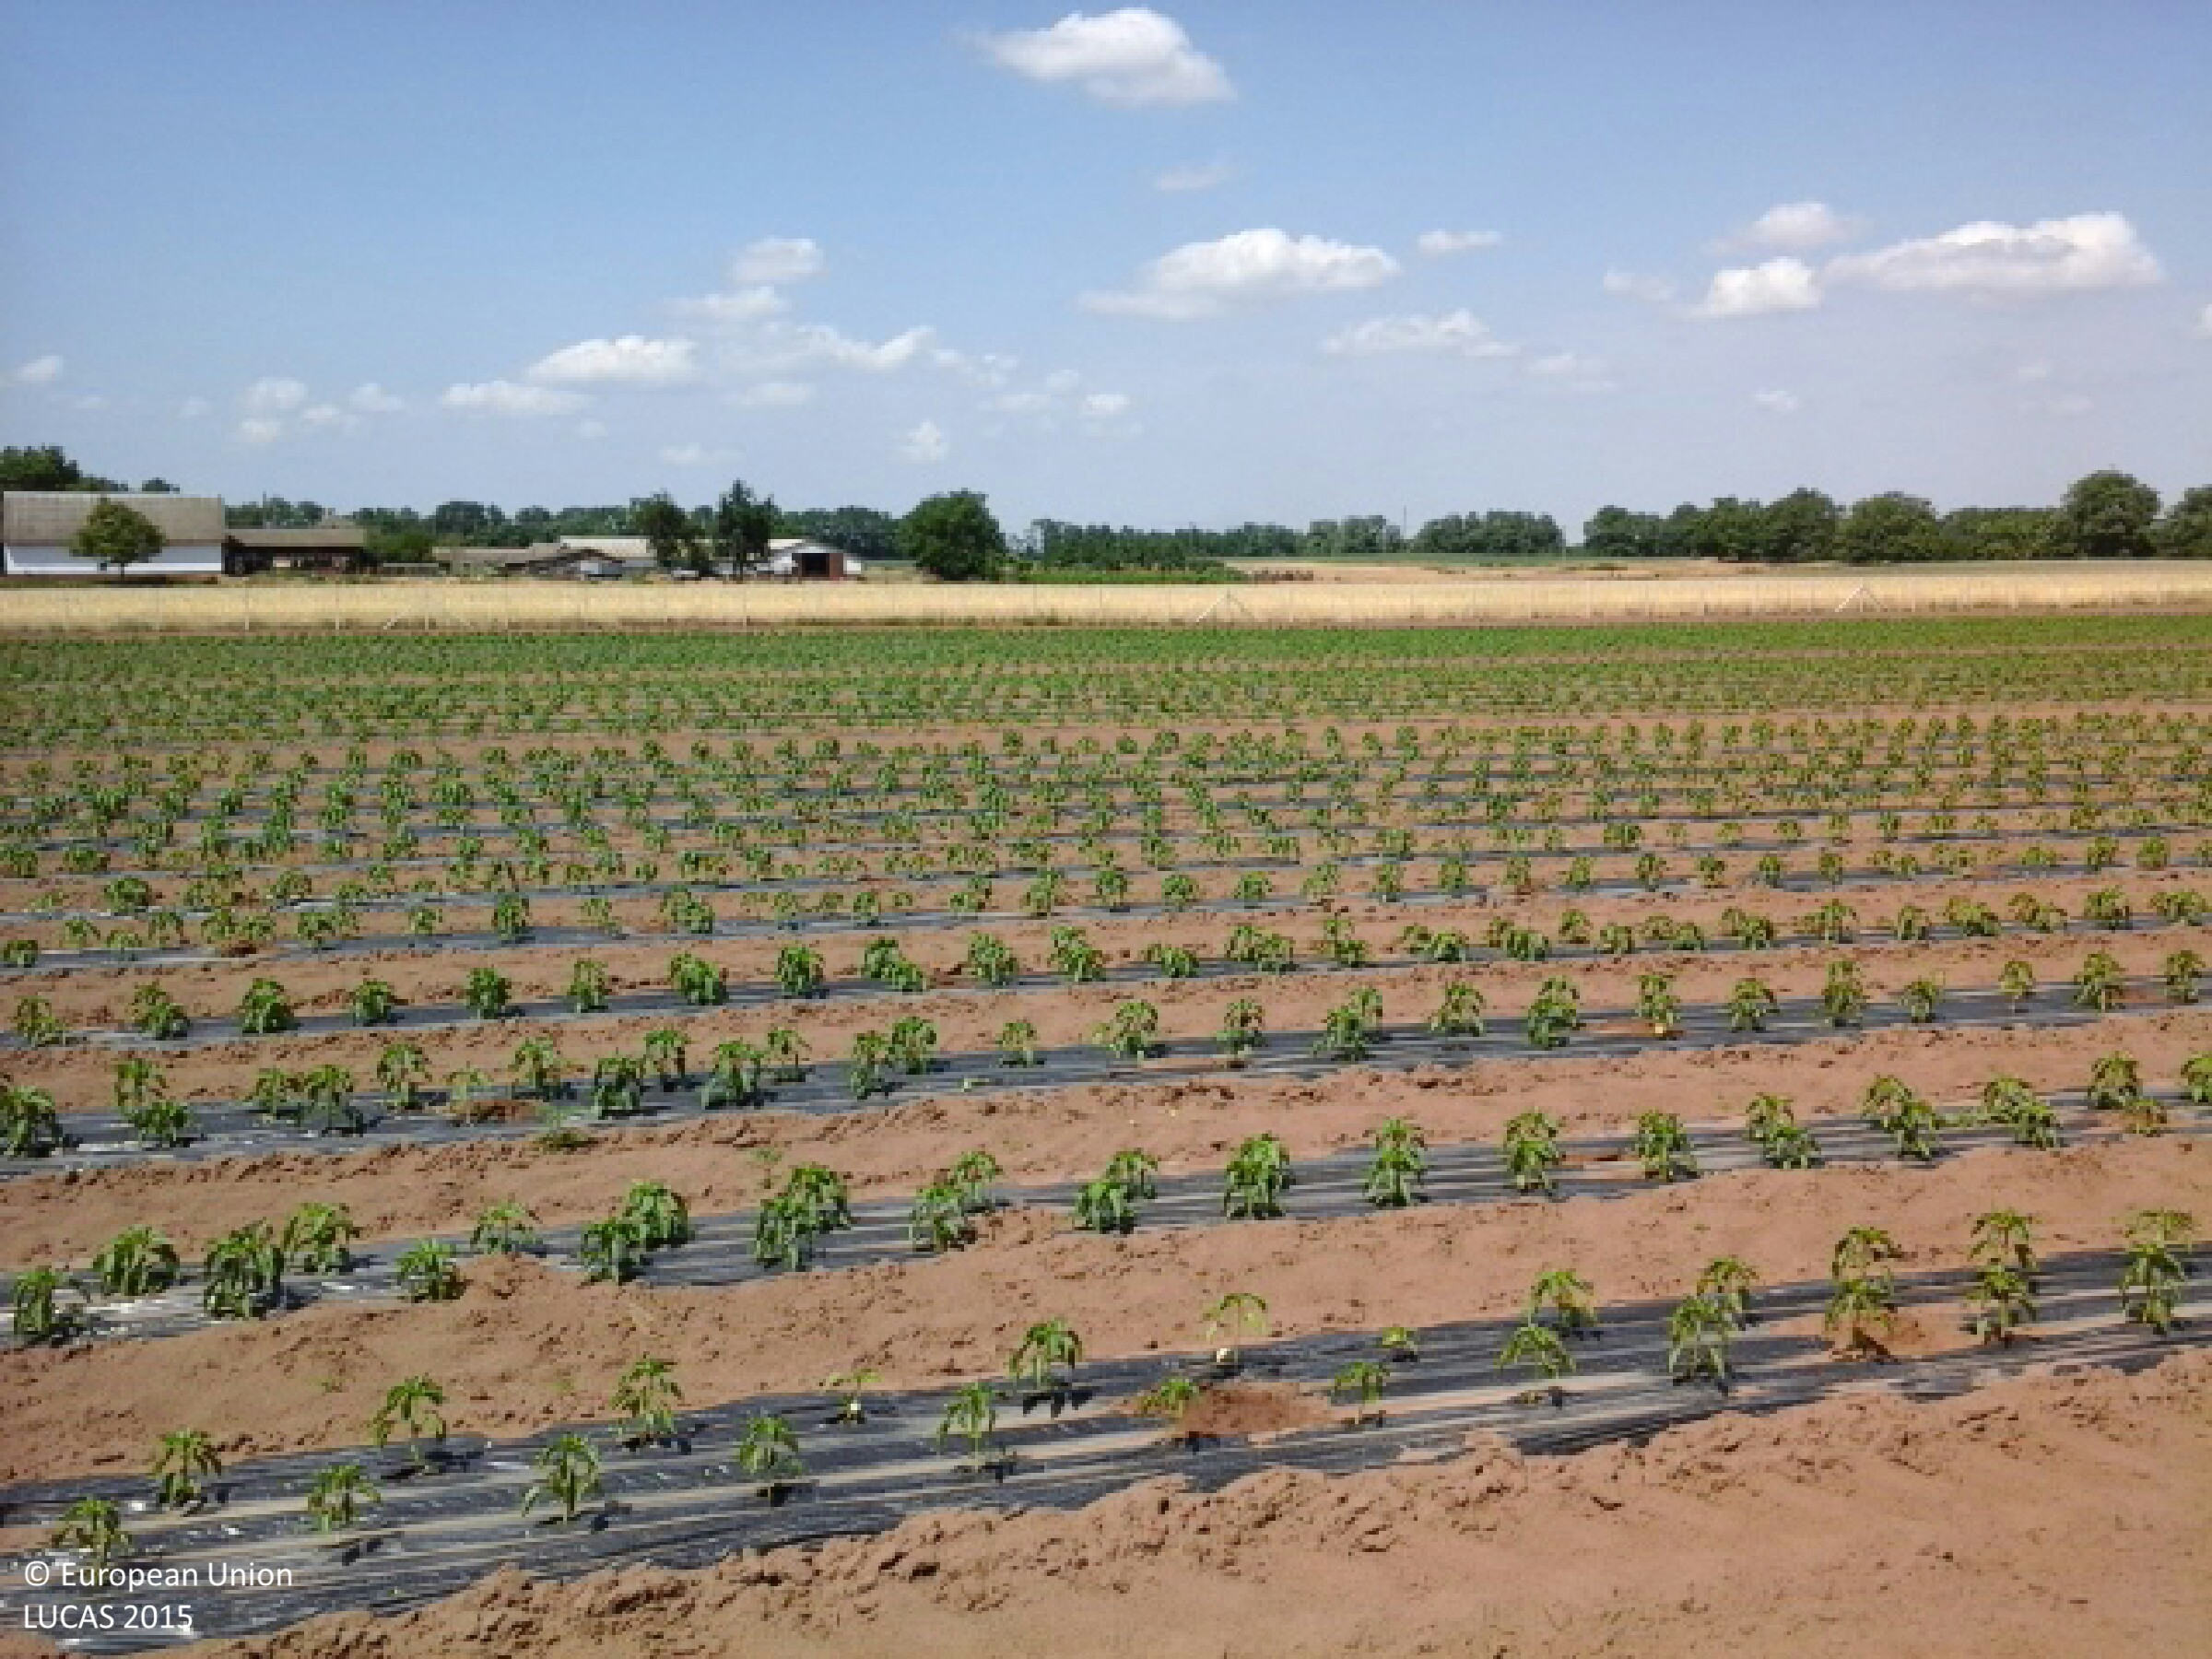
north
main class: Cropland
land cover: Other fresh vegetables
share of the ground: 10 - 25 %
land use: Agriculture (excluding fallow land and kitchen gardens)
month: June
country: HU
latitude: 47.8745
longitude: 21.6656
